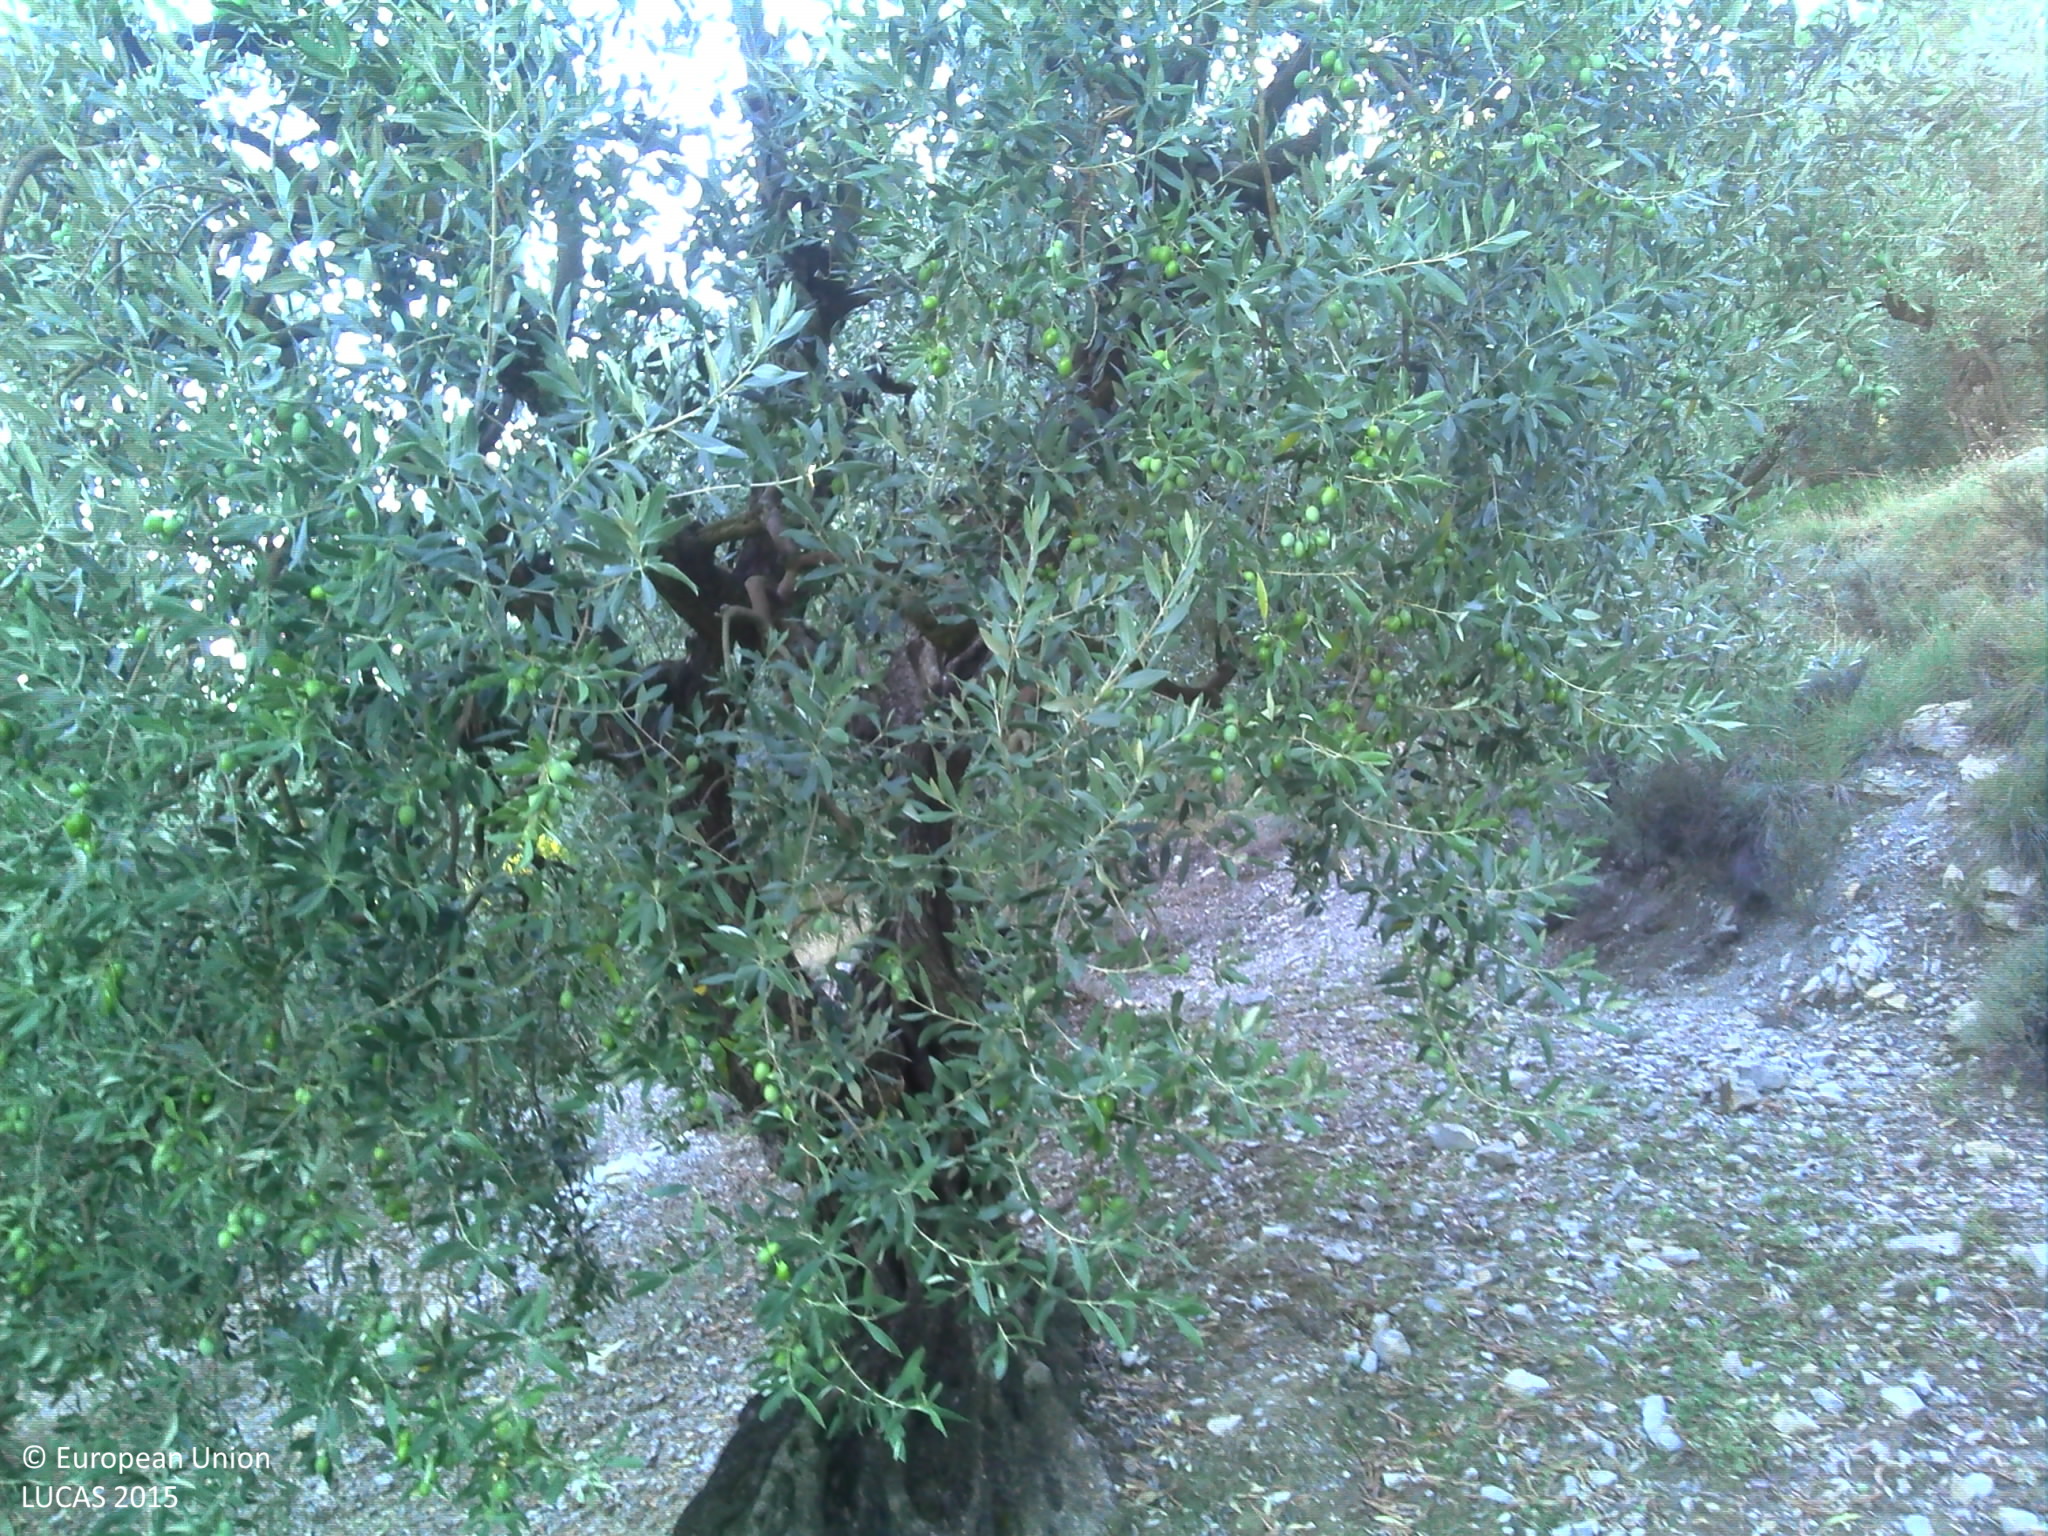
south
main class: Cropland
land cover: Olive groves
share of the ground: > 75 %
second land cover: Rocks and stones
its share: > 75 %
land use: Agriculture (excluding fallow land and kitchen gardens)
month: September
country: FR
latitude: 44.2975
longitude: 5.2824
